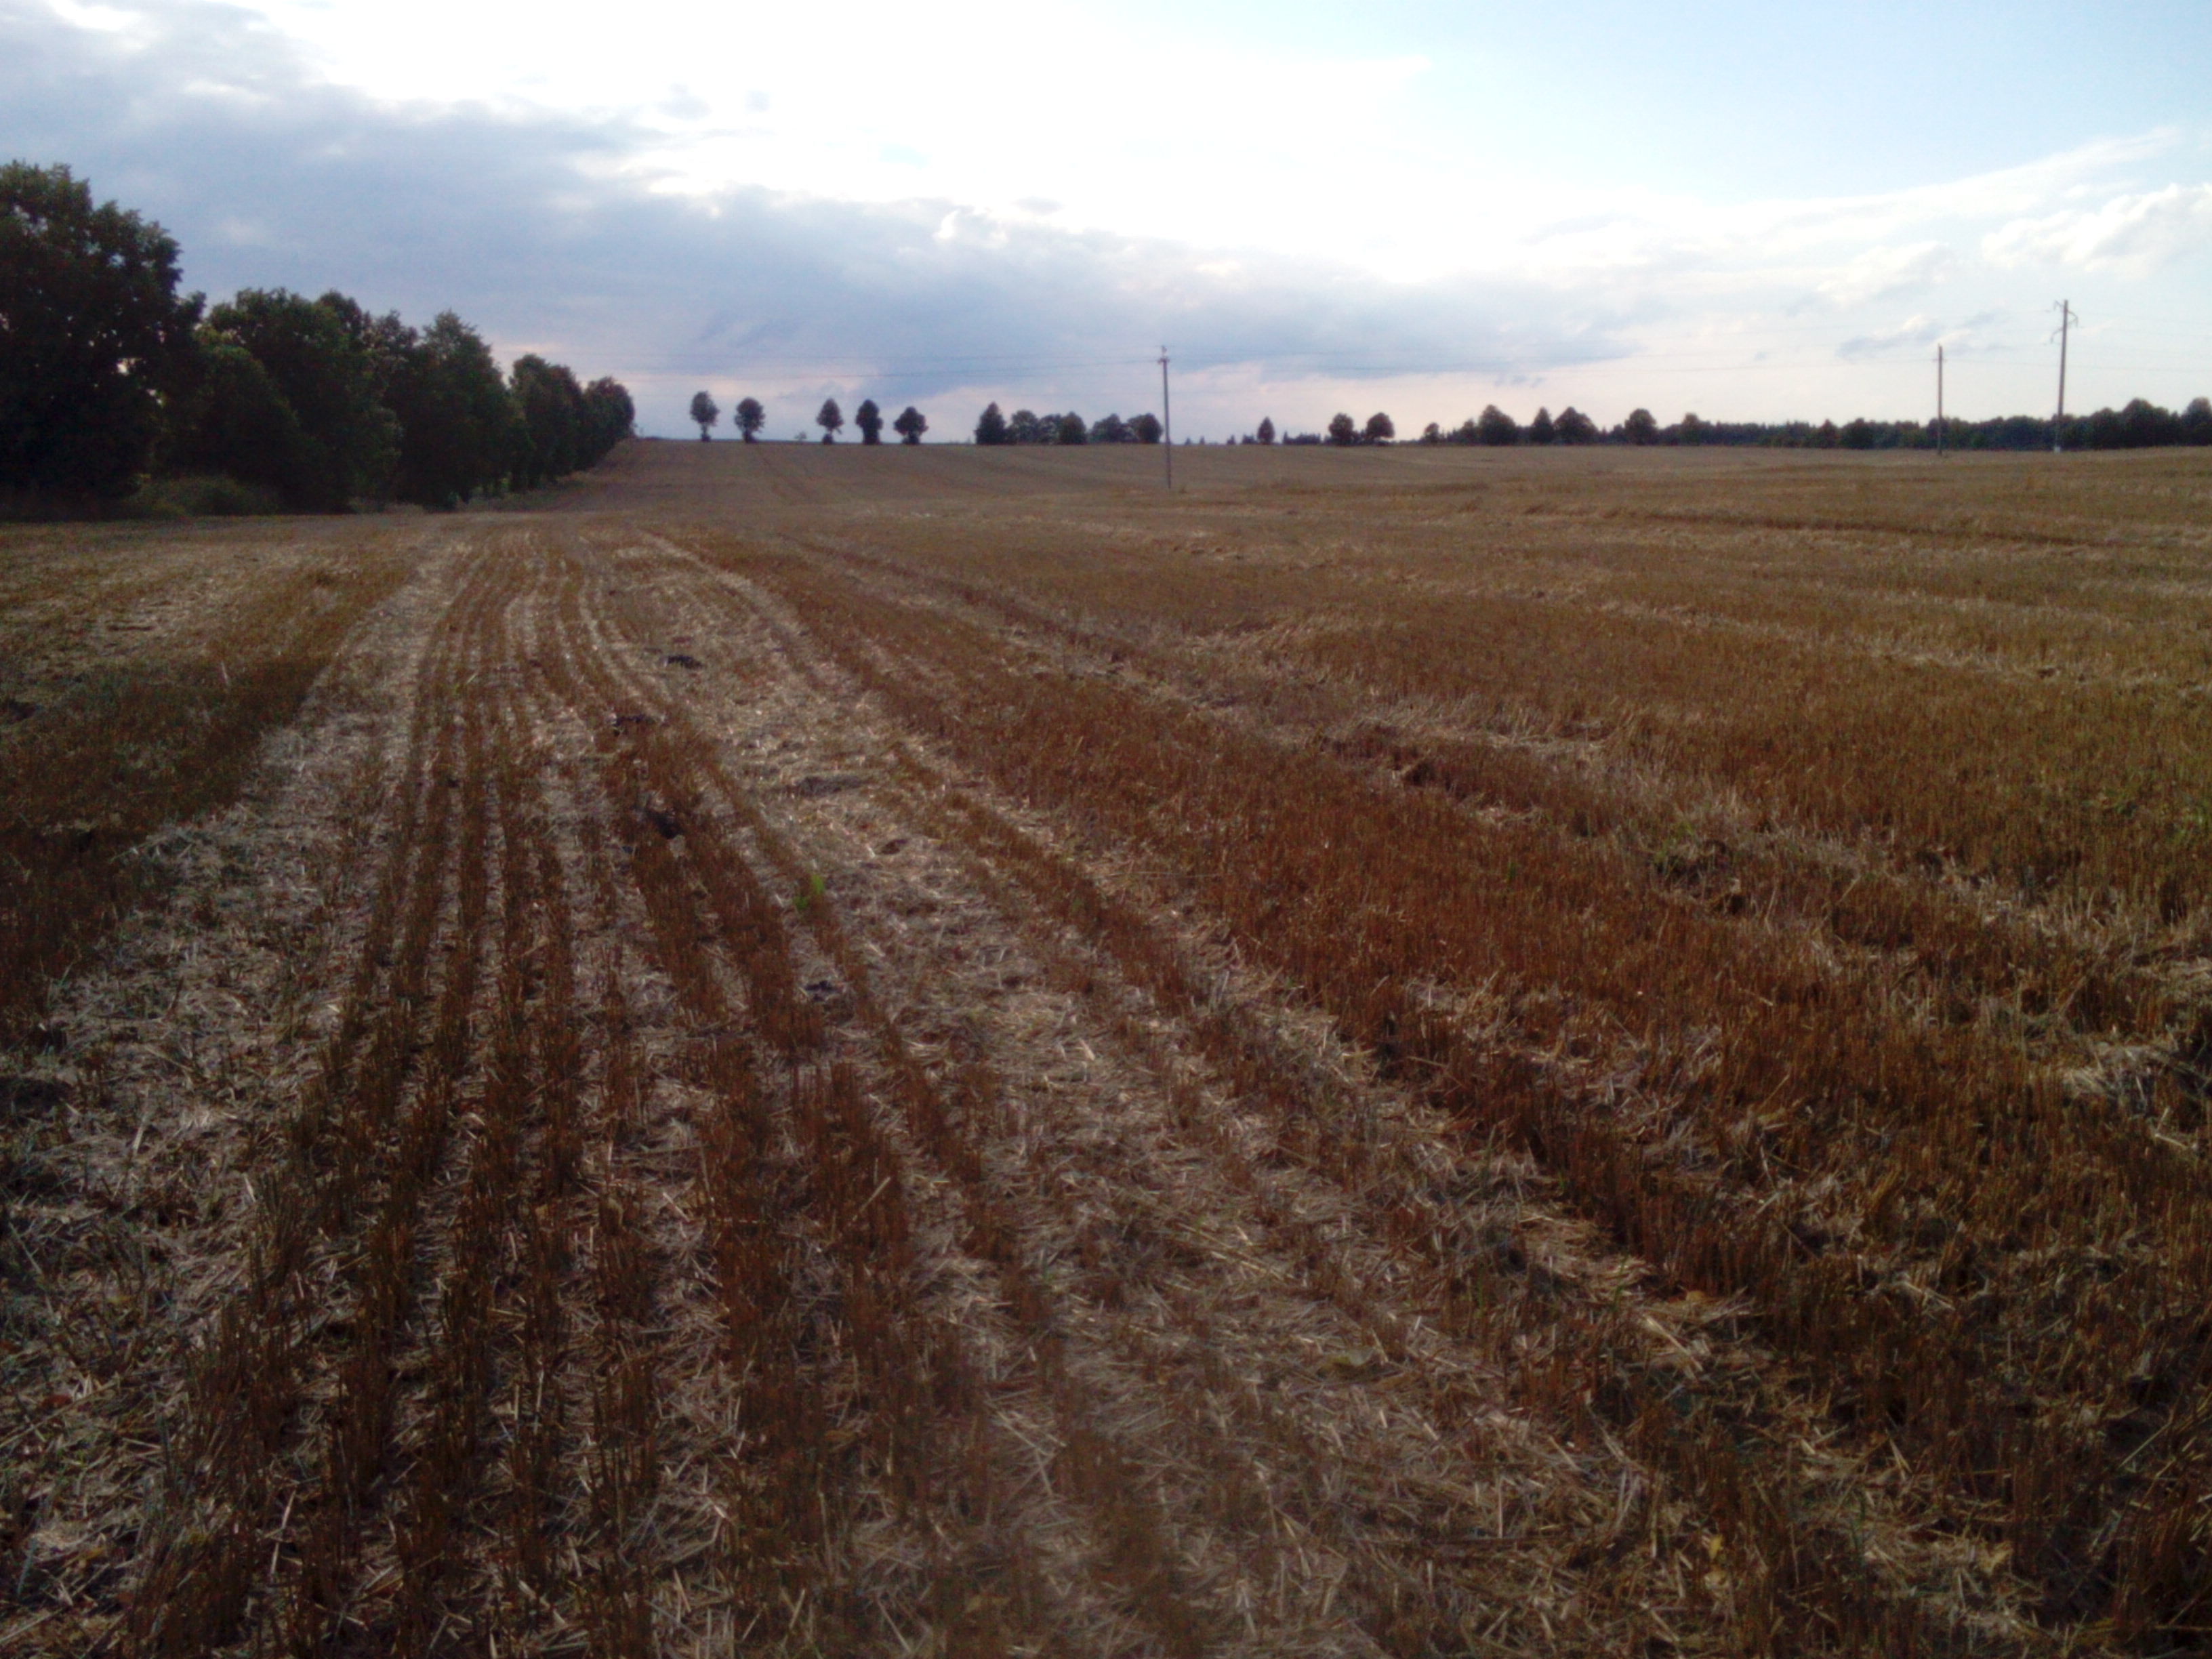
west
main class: Cropland
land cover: Common wheat
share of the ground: > 75 %
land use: Agriculture (excluding fallow land and kitchen gardens)
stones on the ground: < 10 %
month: September
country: LT
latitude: 55.9001
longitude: 22.8768
